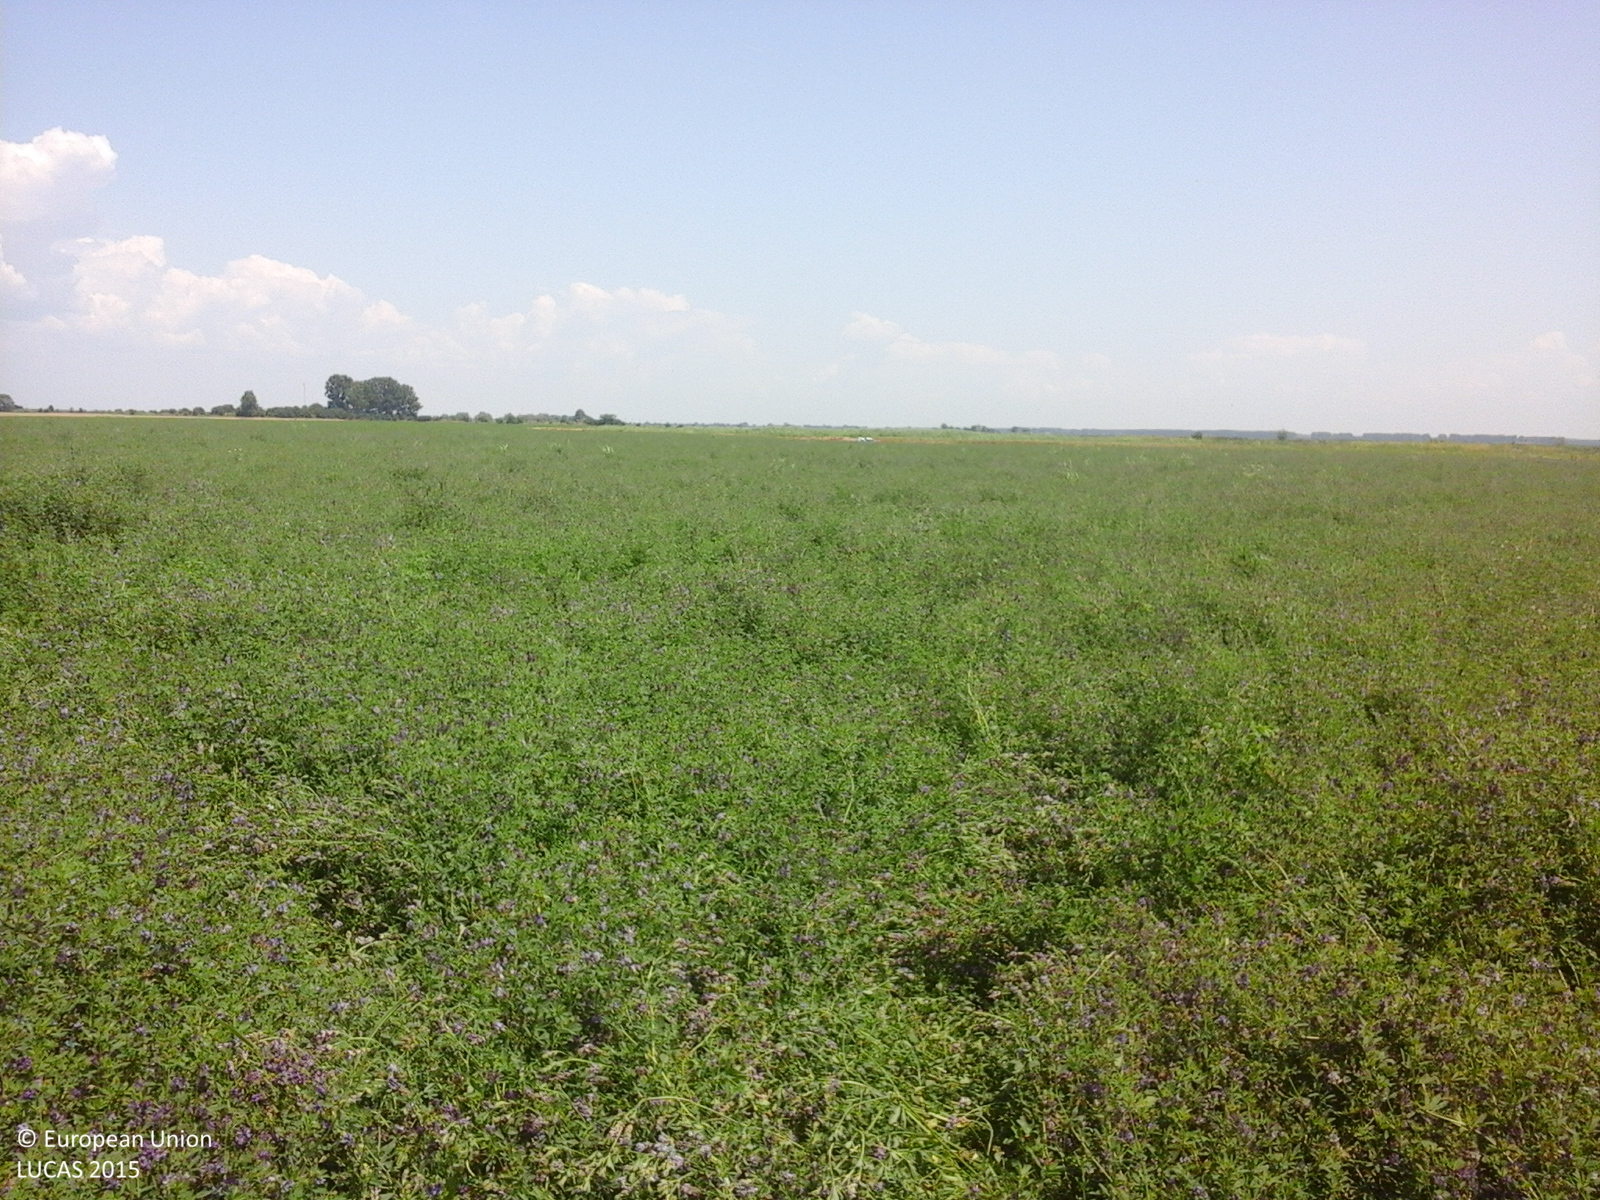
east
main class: Cropland
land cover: Lucerne
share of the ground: > 75 %
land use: Agriculture (excluding fallow land and kitchen gardens)
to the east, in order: Lucerne
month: July
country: RO
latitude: 43.9954
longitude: 26.0227
